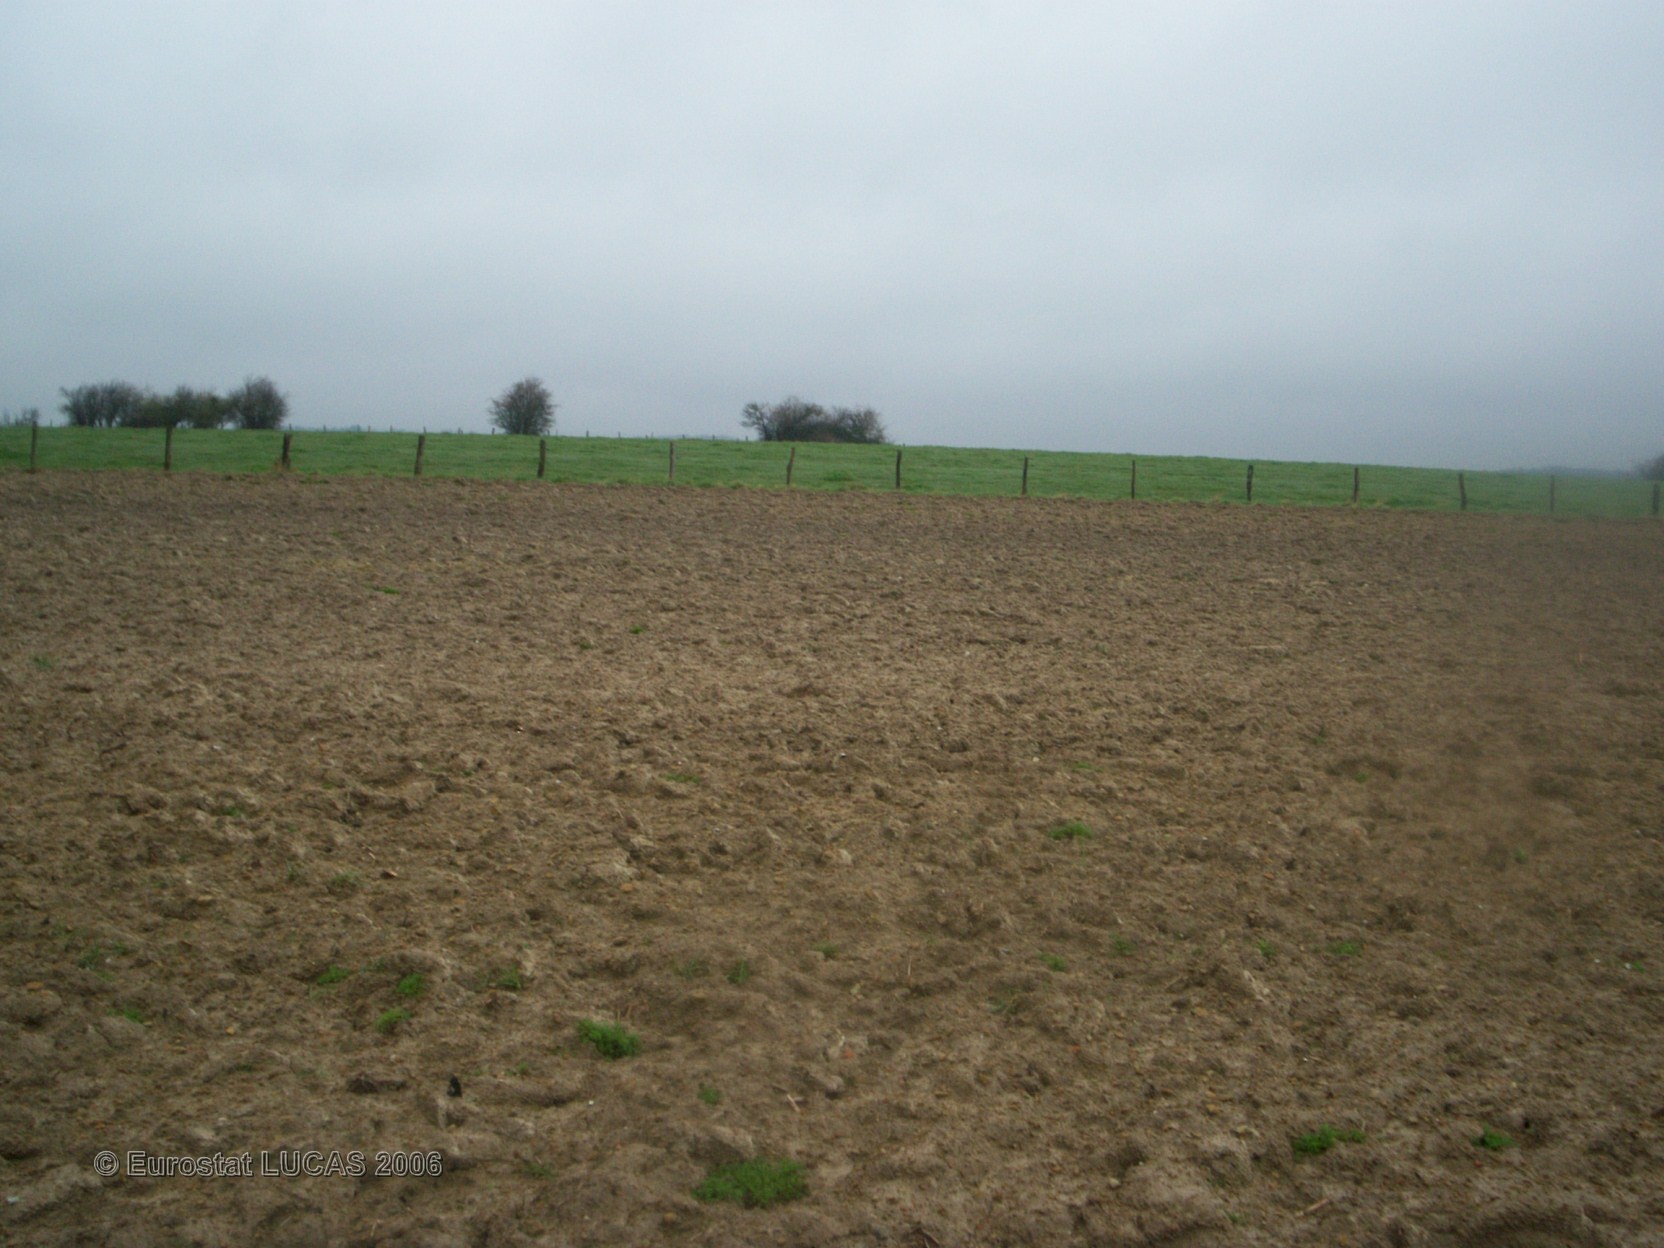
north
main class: Cropland
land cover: Maize
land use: Agriculture (excluding fallow land and kitchen gardens)
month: June
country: FR
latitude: 49.1589
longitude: 5.0751
